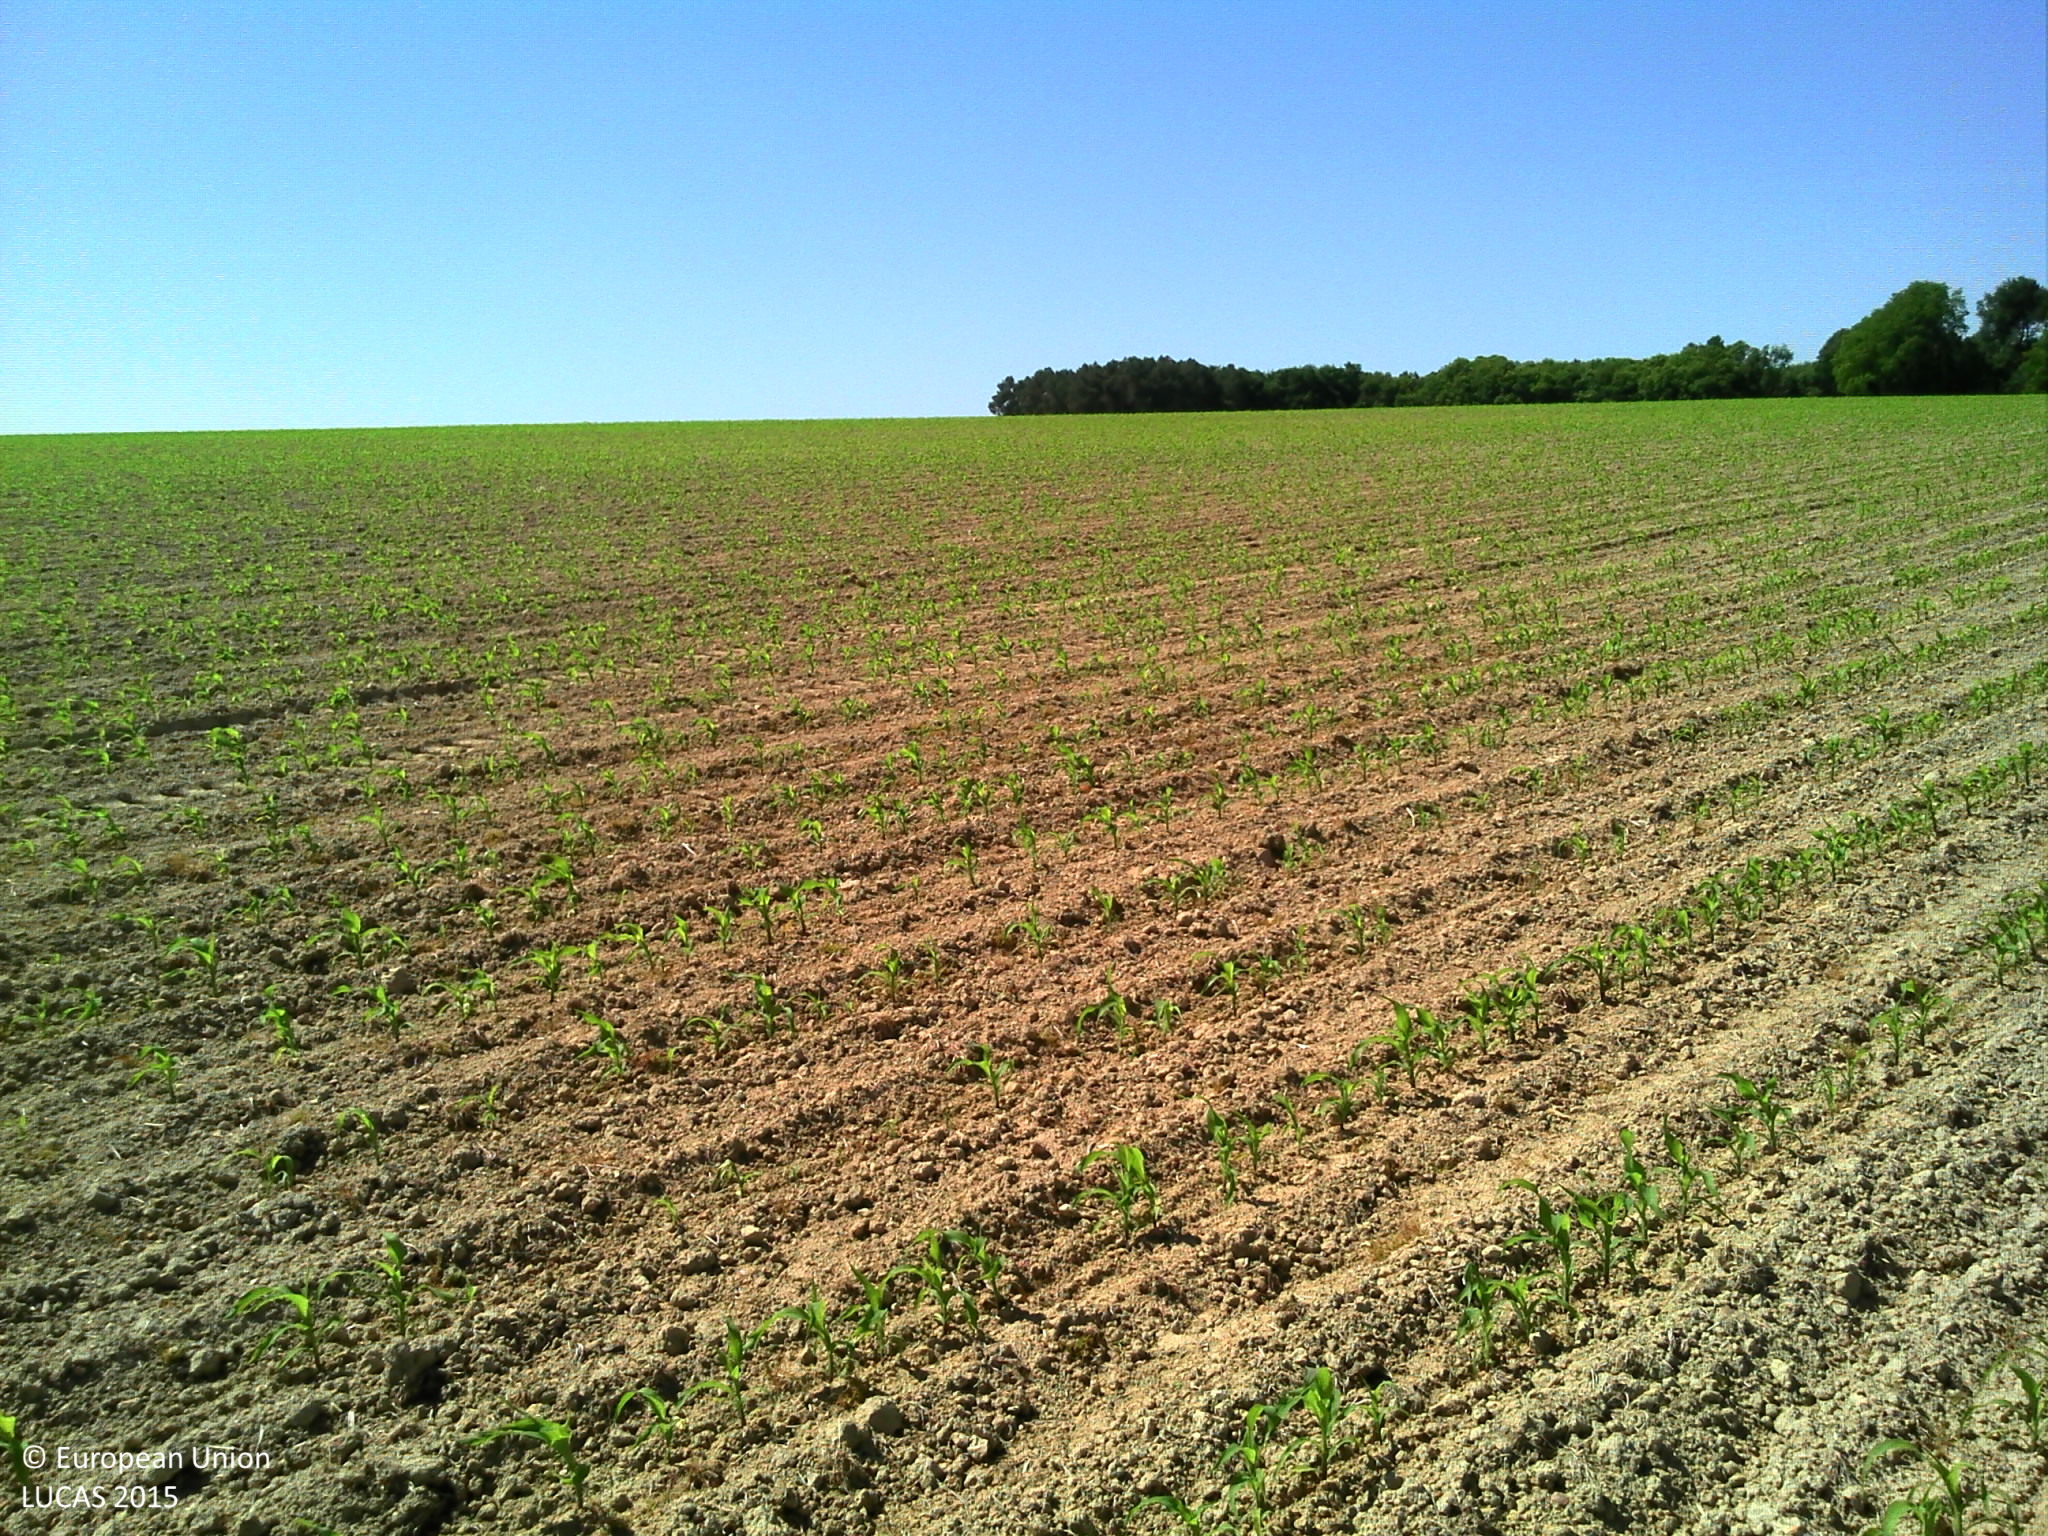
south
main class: Cropland
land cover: Maize
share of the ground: 10 - 25 %
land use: Agriculture (excluding fallow land and kitchen gardens)
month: June
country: FR
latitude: 46.9100
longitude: 0.5413
